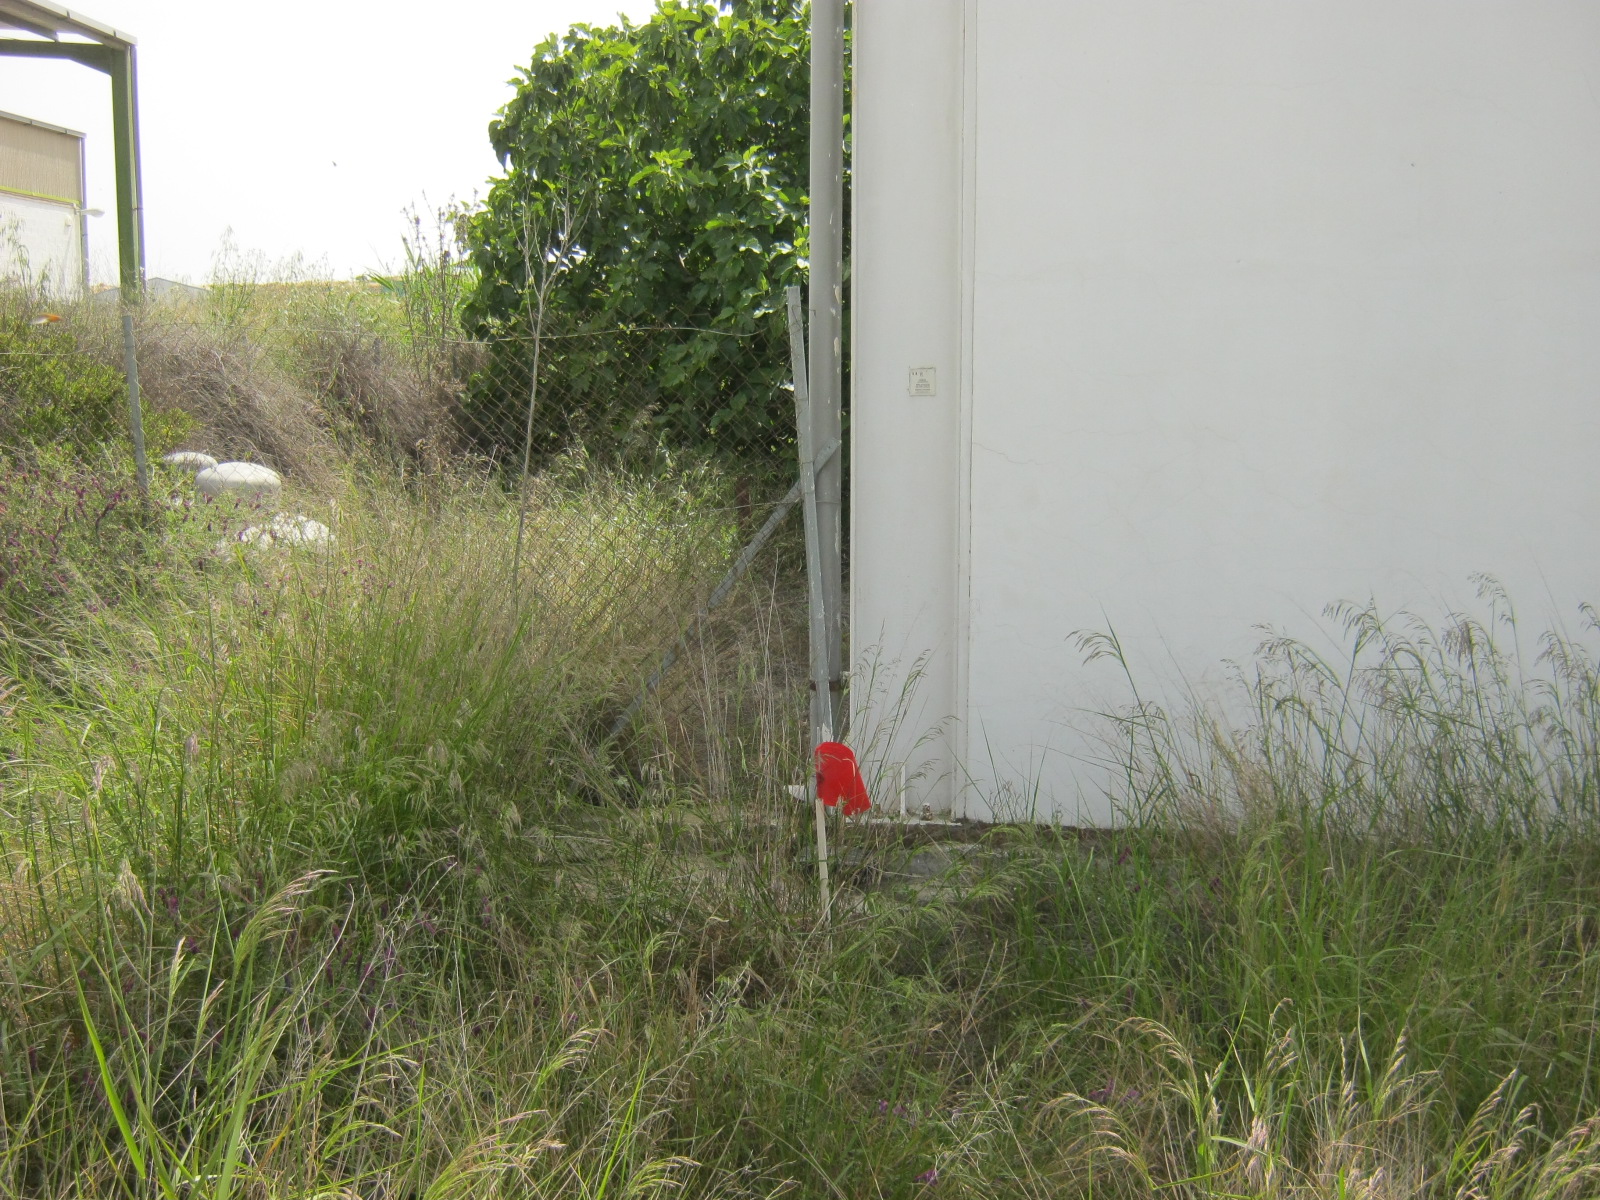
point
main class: Grassland
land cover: Spontaneously vegetated surfaces
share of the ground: > 75 %
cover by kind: herbaceous plants 100 %
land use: Logistics and storage
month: April
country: CY
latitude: 35.0473
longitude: 33.4003
